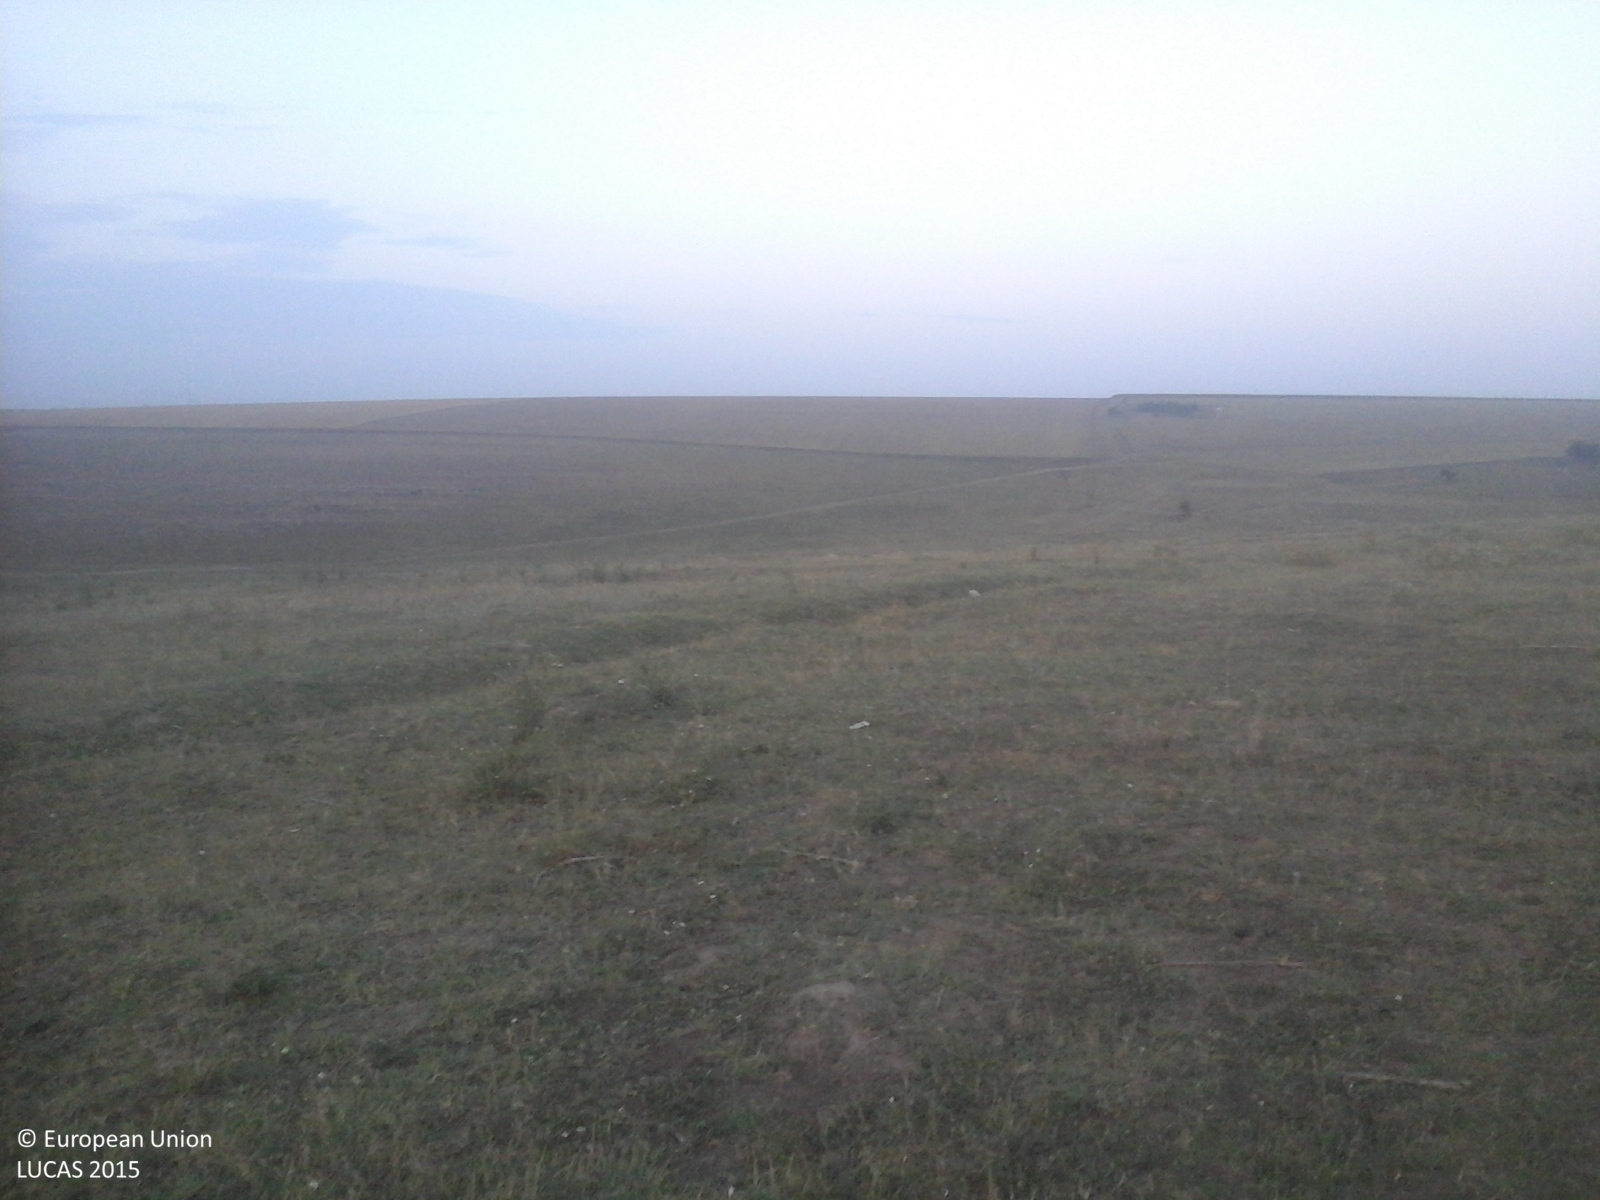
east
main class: Grassland
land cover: Grassland without tree/shrub cover
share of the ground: > 75 %
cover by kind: herbaceous plants 100 %
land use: Agriculture (excluding fallow land and kitchen gardens)
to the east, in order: Grassland without tree/shrub cover; Ditches and canals; Grassland without tree/shrub cover; Tracks; Grassland without tree/shrub cover; Tracks; Grassland without tree/shrub cover; Tracks; Grassland without tree/shrub cover; Ditches and canals; Grassland without tree/shrub cover; Tracks; Grassland without tree/shrub cover
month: August
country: RO
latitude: 44.1584
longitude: 28.1262
